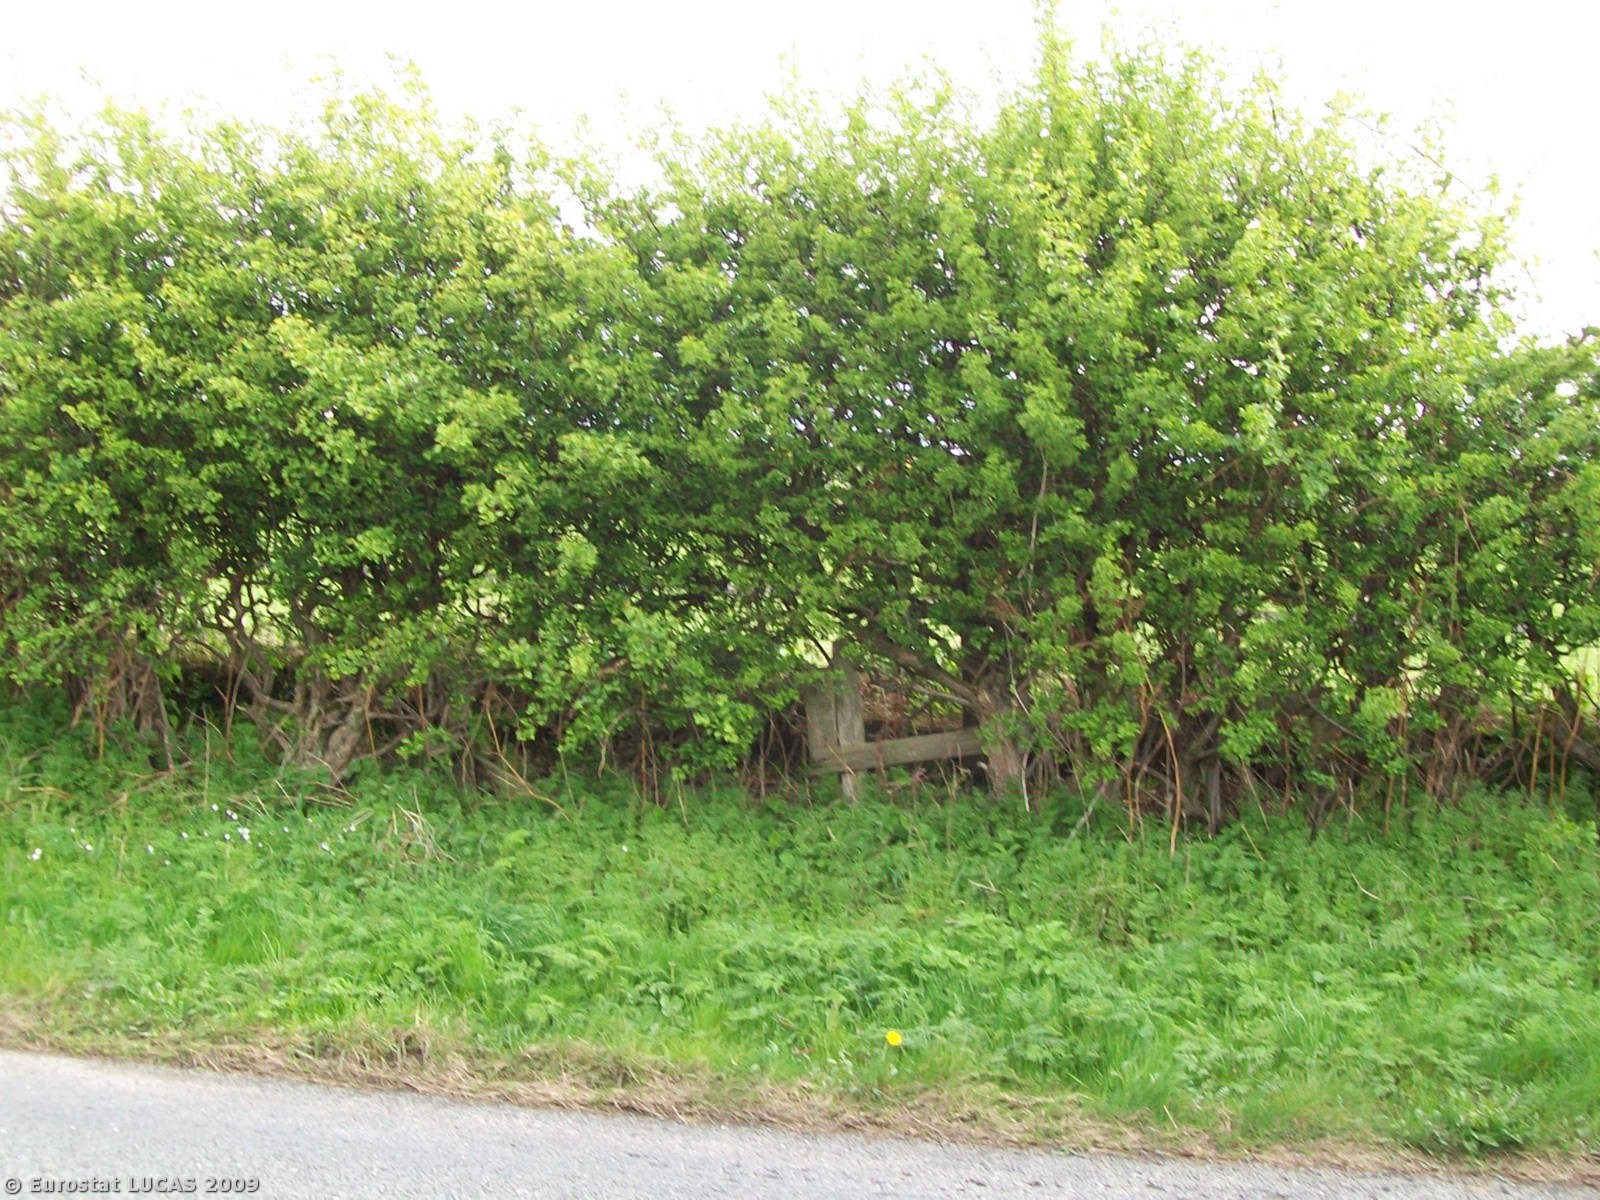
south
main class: Cropland
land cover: Oats
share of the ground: 10 - 25 %
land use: Agriculture (excluding fallow land and kitchen gardens)
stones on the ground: < 10 %
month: April
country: GB
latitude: 54.8368
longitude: -1.6493
